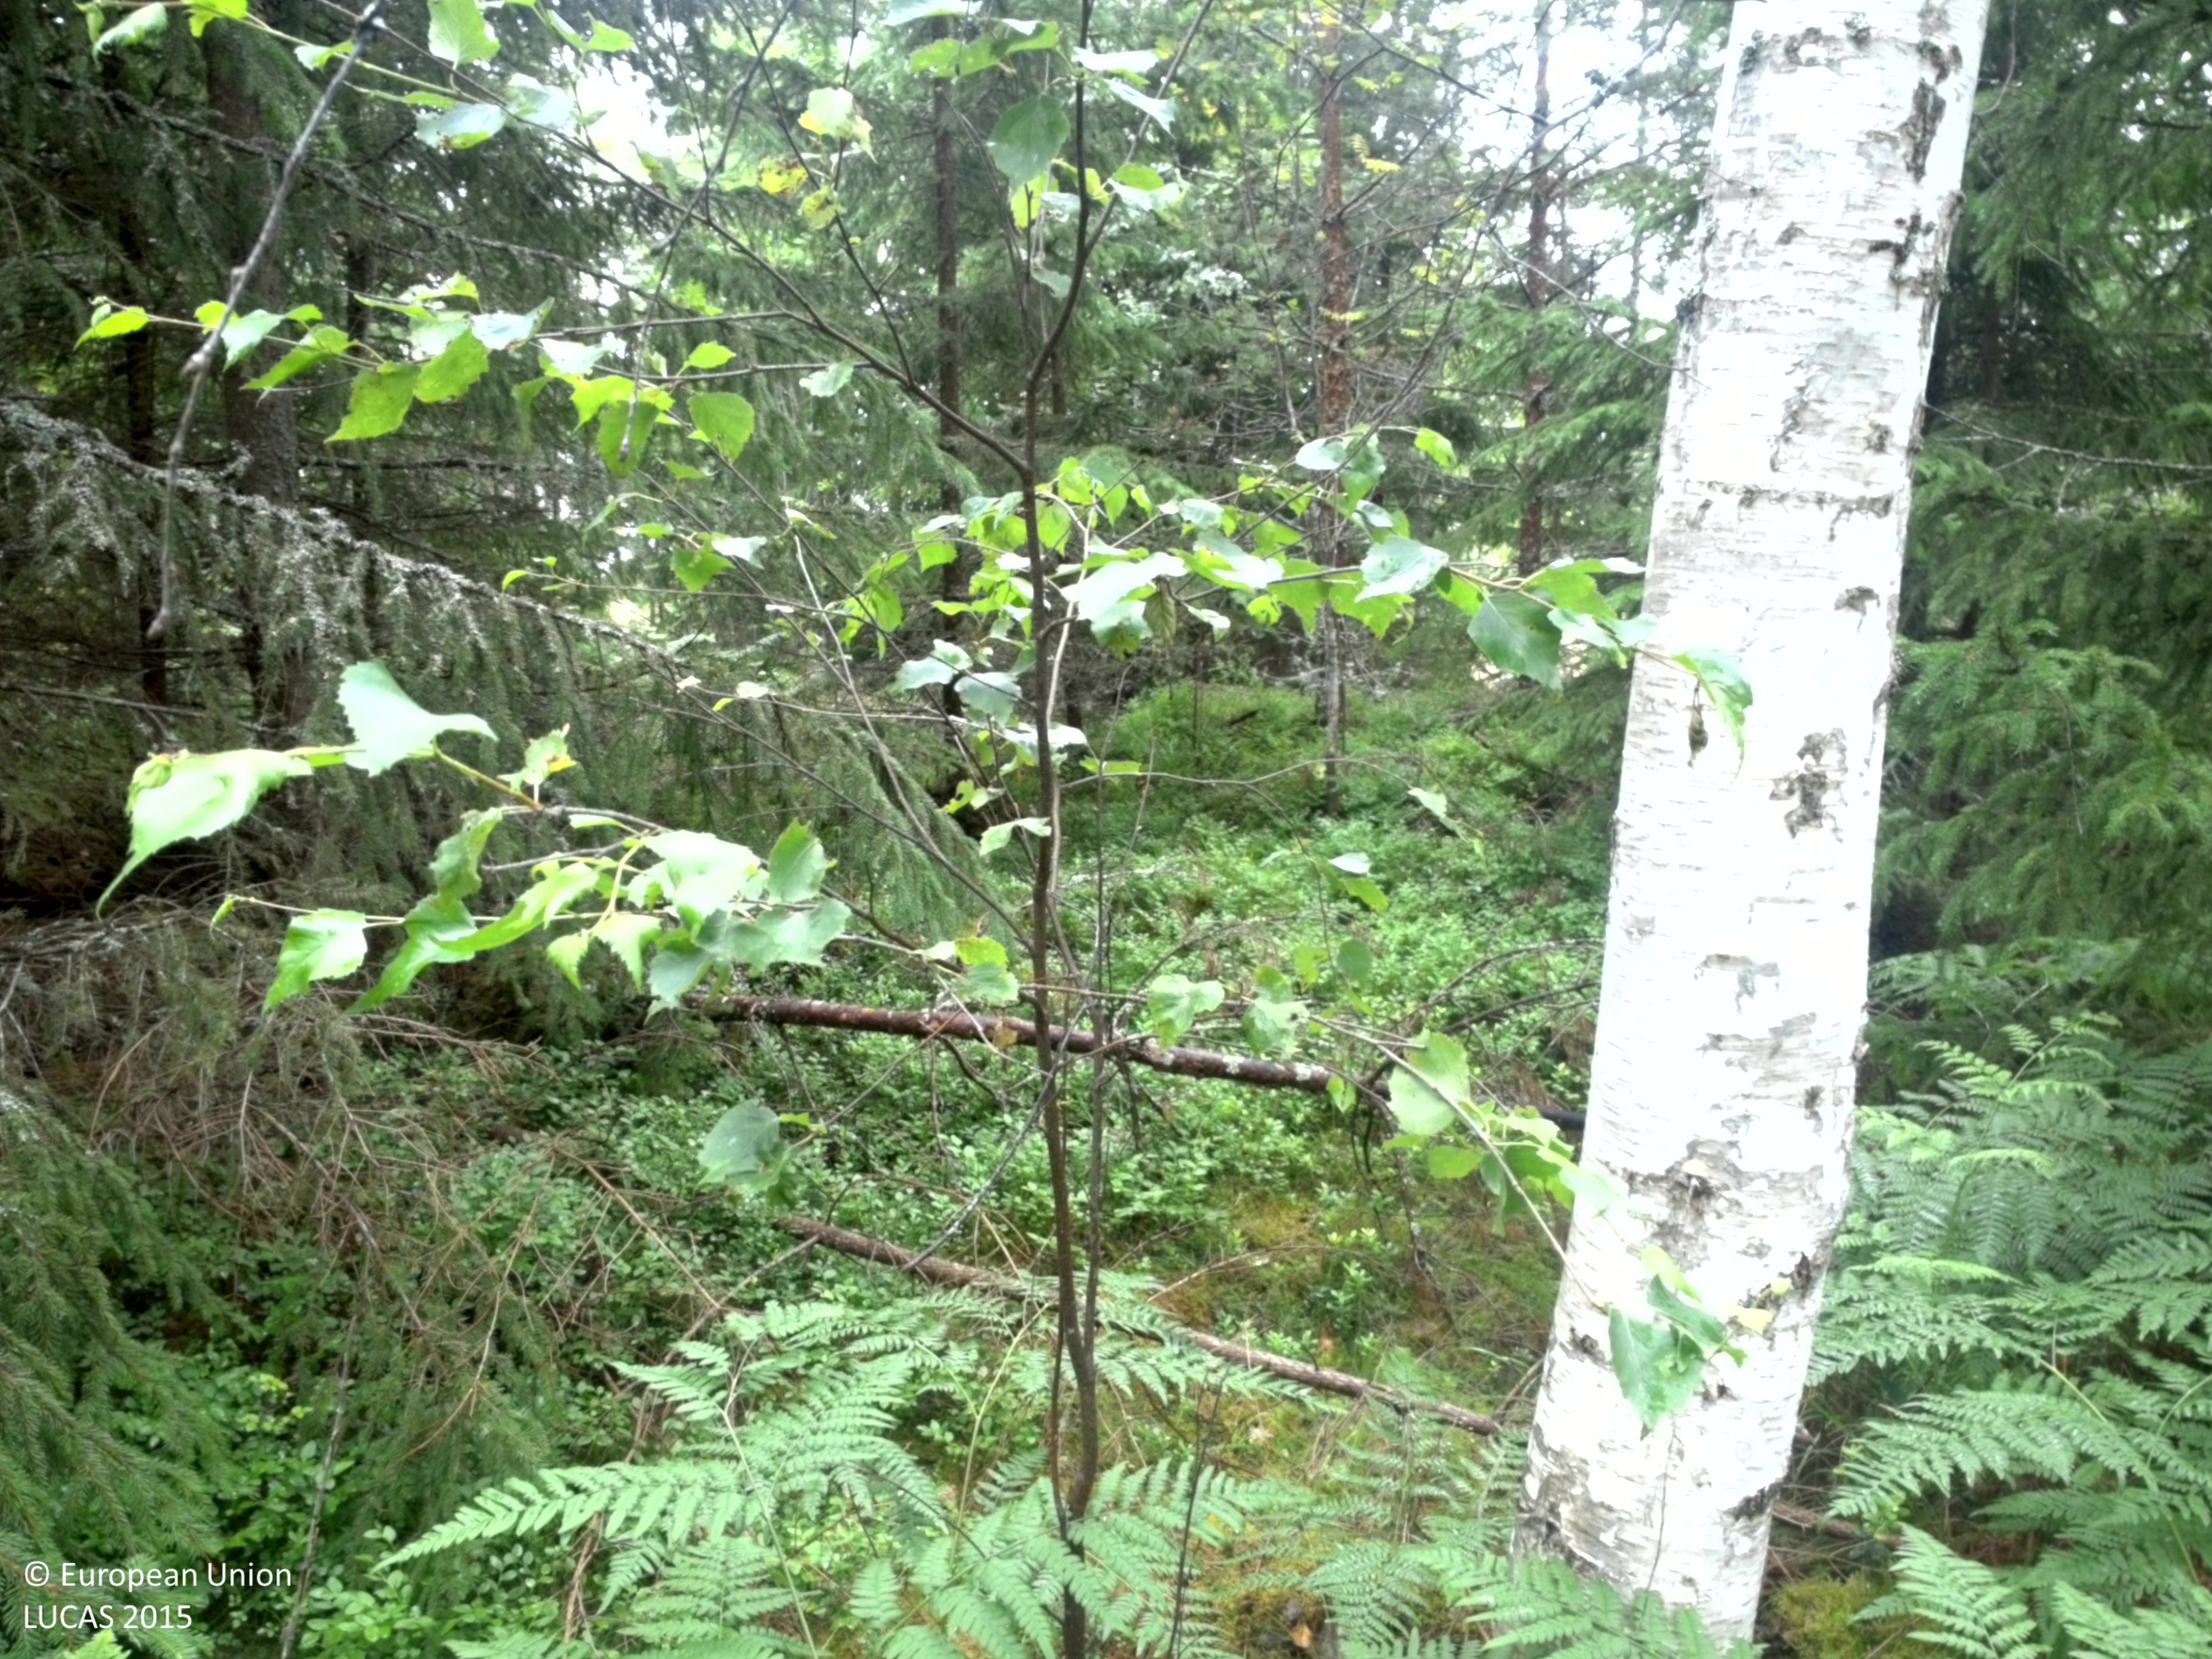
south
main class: Woodland
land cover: Other coniferous woodland
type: boreal forest
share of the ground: > 75 %
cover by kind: coniferous forest trees 60 %, broadleaved forest trees 20 %, herbaceous plants 20 %
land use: Forestry
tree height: > 5 m
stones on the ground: < 10 %
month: July
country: SE
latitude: 60.1587
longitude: 17.2162
